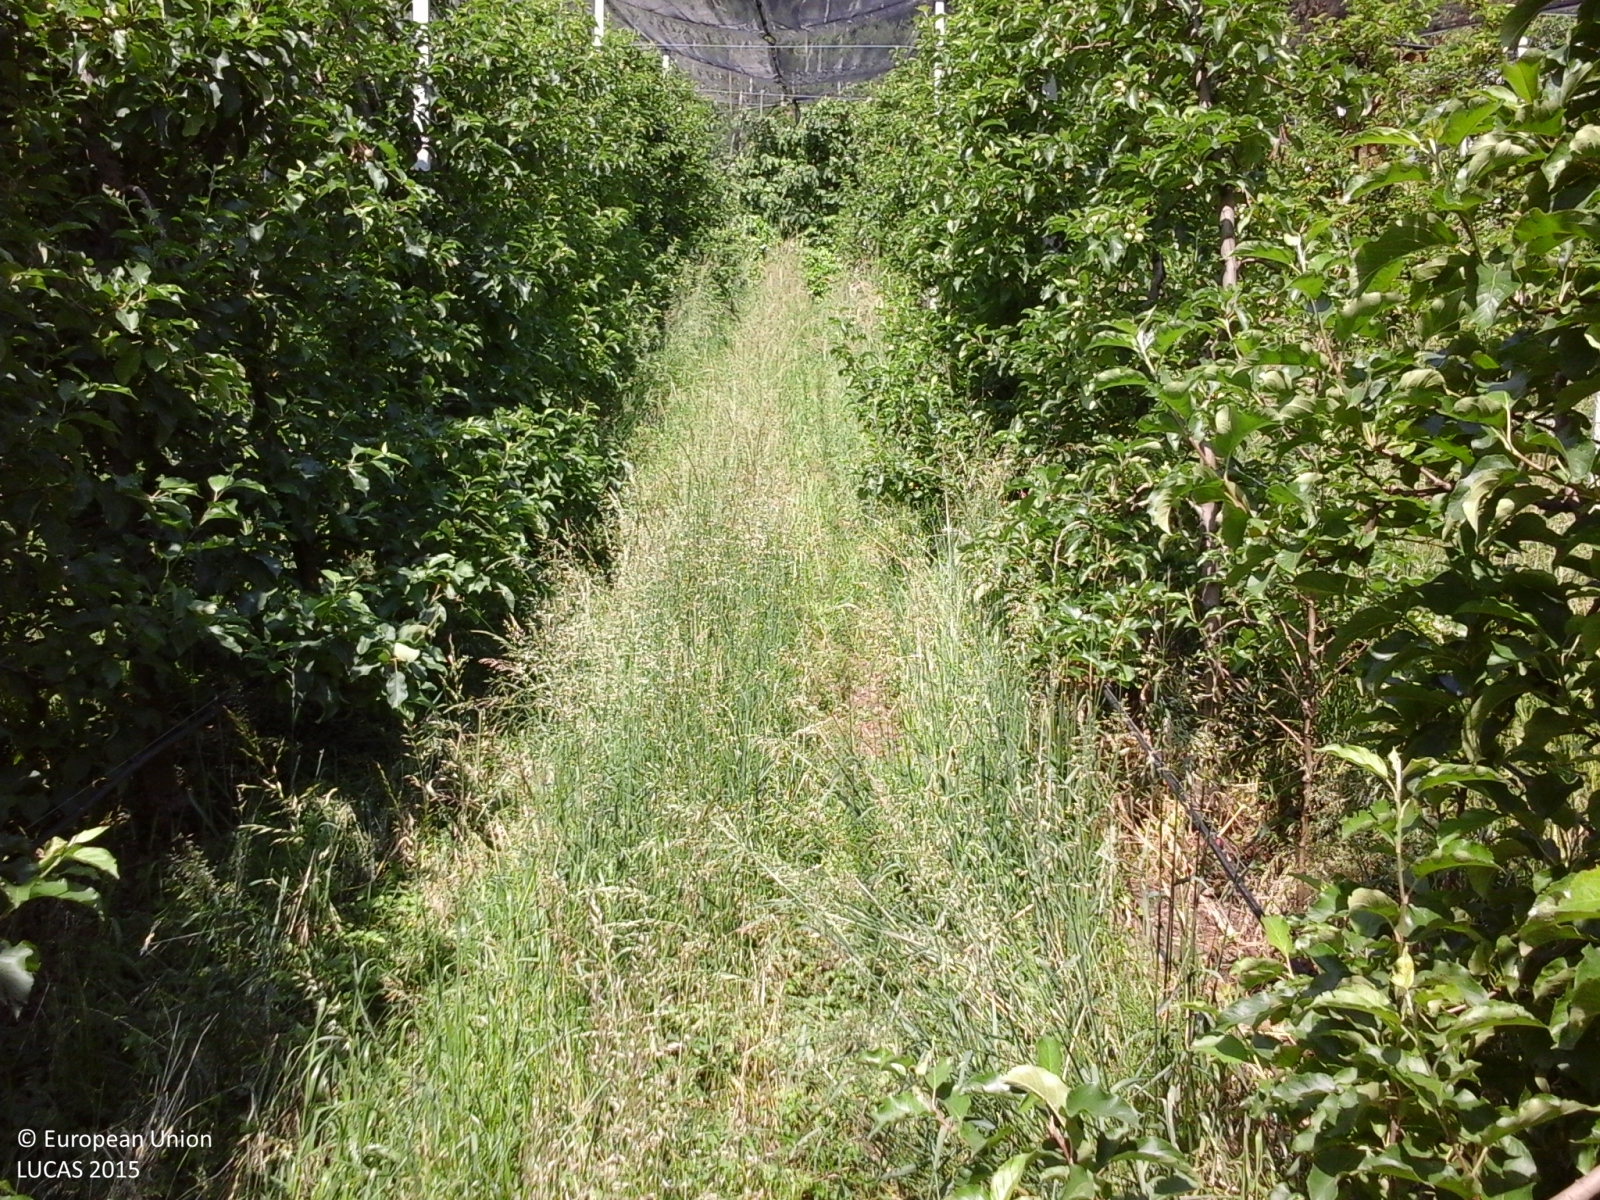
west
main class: Cropland
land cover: Apple fruit
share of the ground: > 75 %
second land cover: Grassland without tree/shrub cover
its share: > 75 %
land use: Agriculture (excluding fallow land and kitchen gardens)
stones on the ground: < 10 %
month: May
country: IT
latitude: 46.6154
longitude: 11.1347
